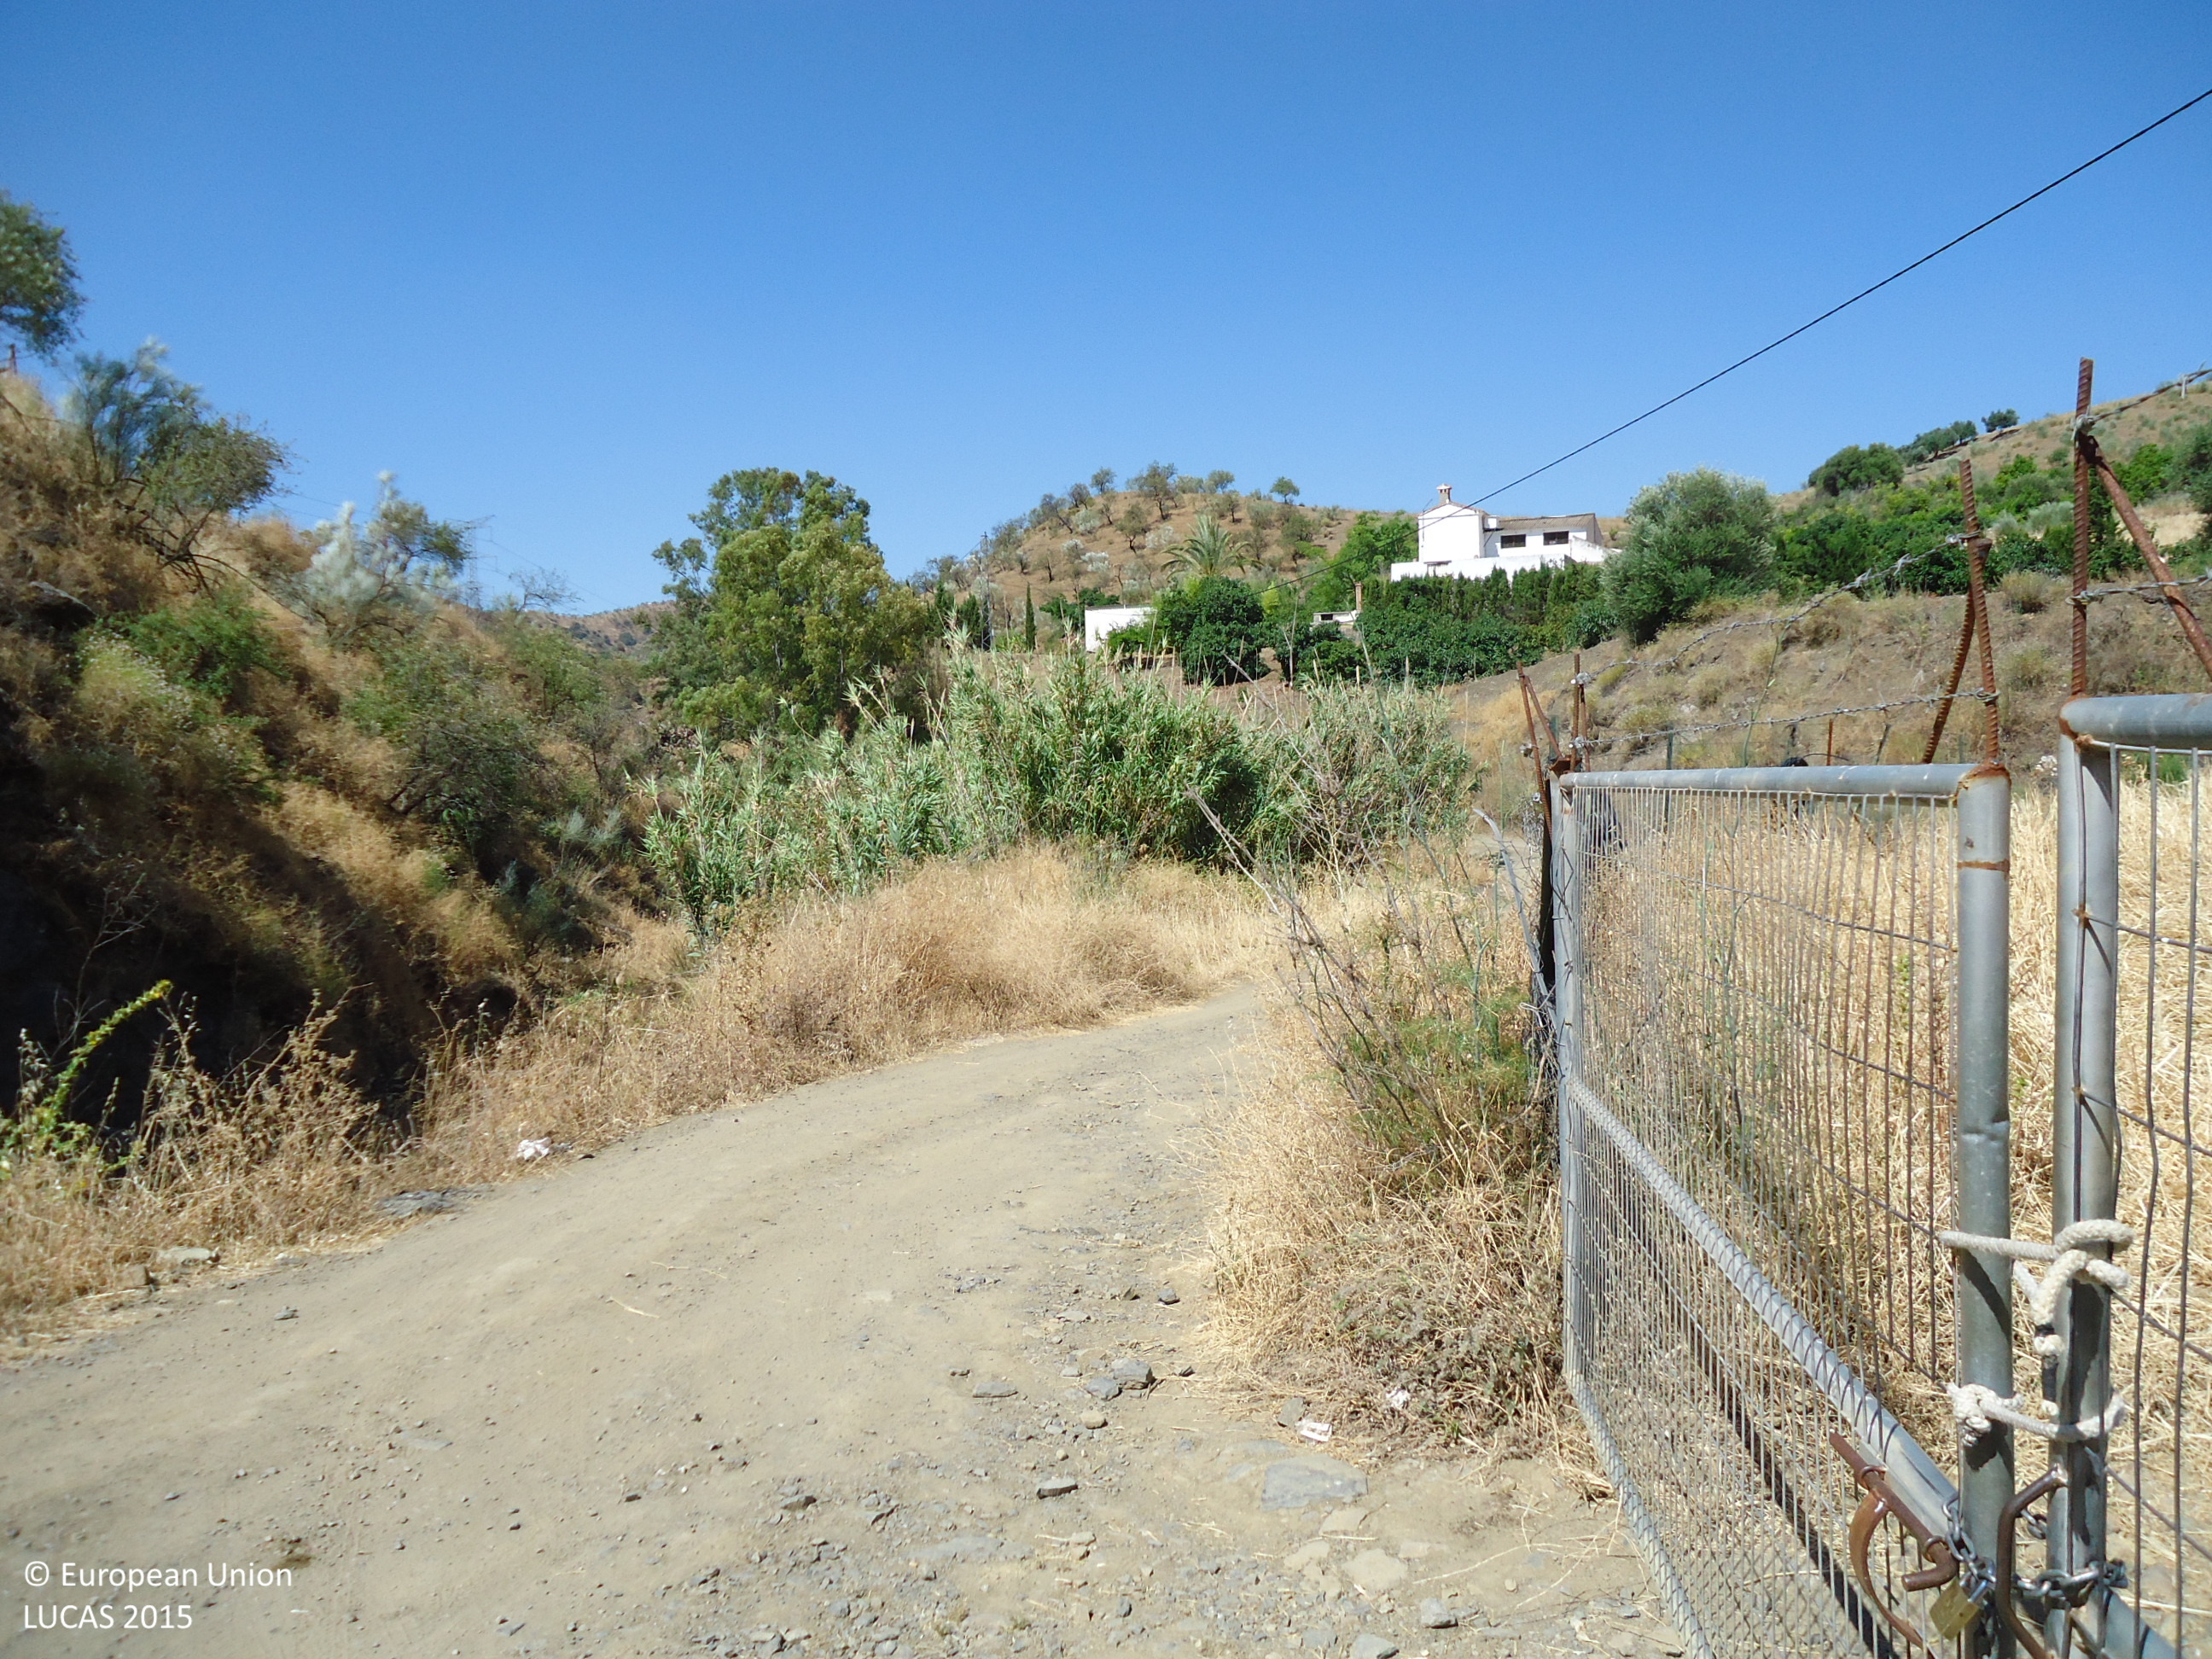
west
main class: Grassland
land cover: Grassland without tree/shrub cover
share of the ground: > 75 %
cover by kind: herbaceous plants 100 %
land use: Agriculture (excluding fallow land and kitchen gardens)
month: June
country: ES
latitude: 36.8244
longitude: -4.7836
